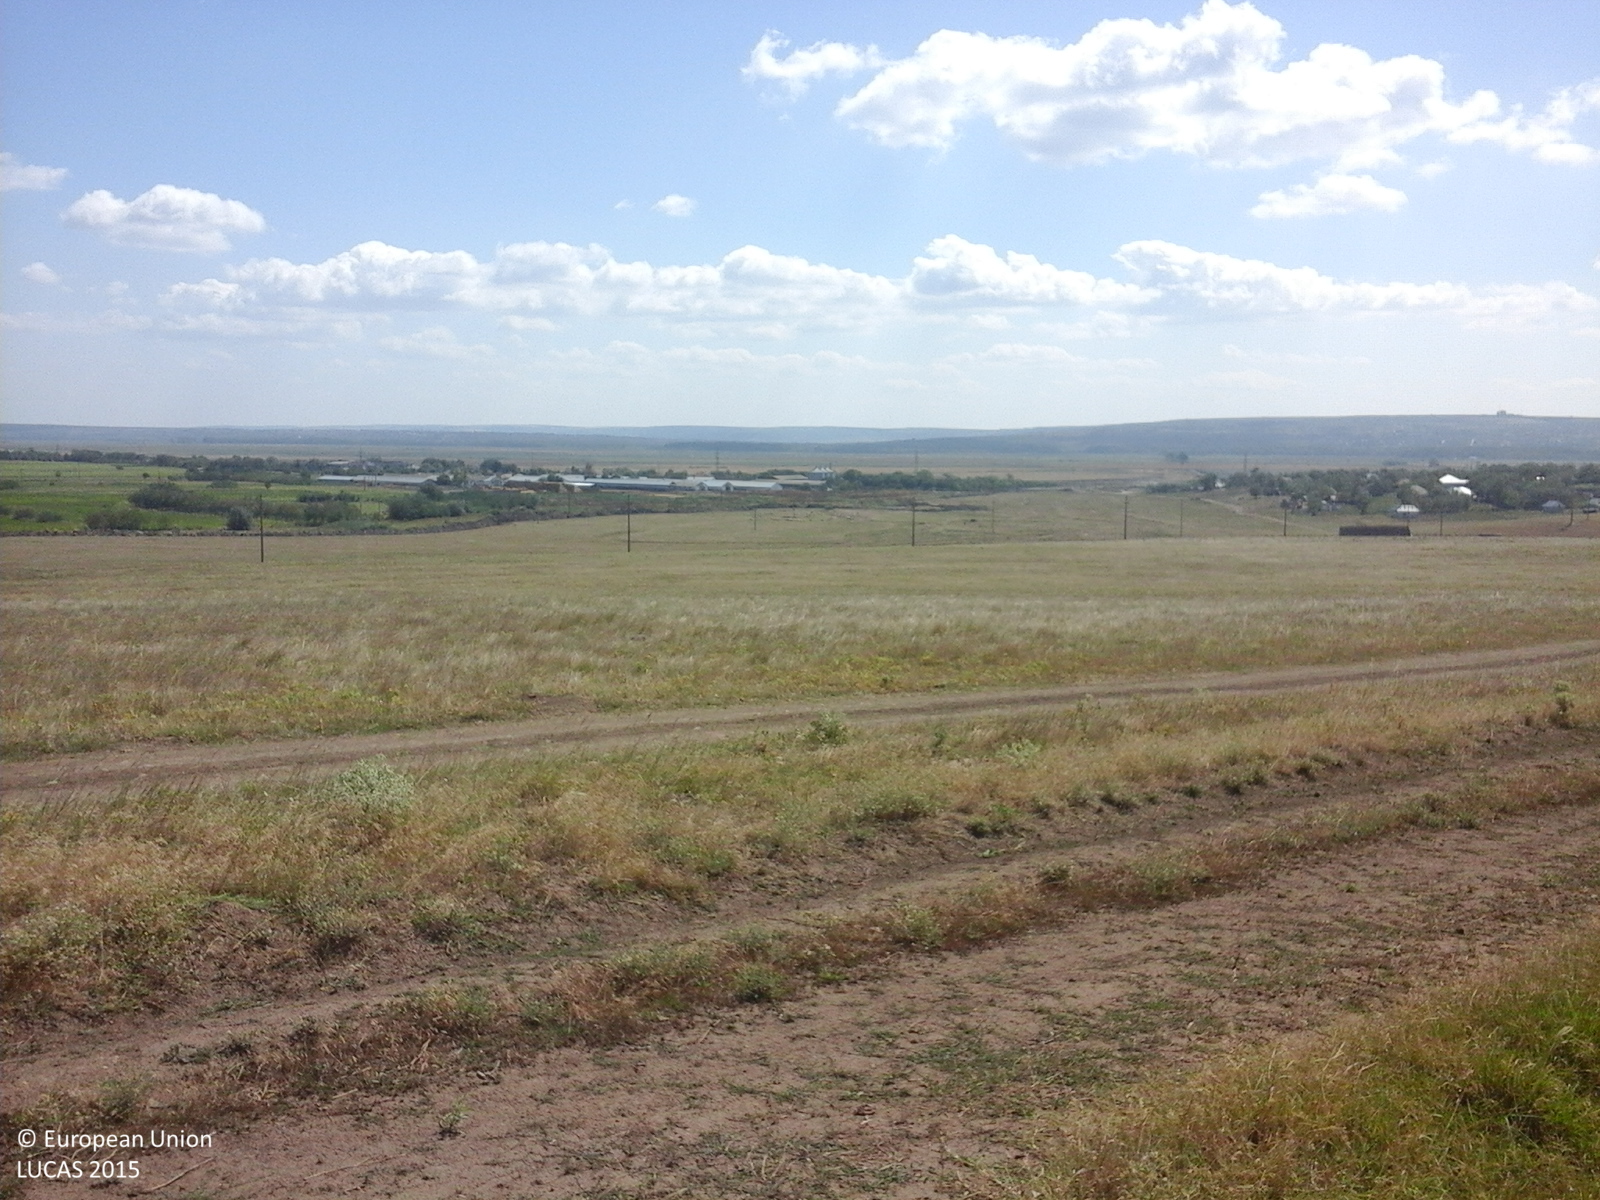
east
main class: Grassland
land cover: Grassland without tree/shrub cover
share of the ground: > 75 %
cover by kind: herbaceous plants 100 %
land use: Agriculture (excluding fallow land and kitchen gardens)
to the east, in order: Grassland without tree/shrub cover; Tracks; Grass margins; Tracks; Grassland without tree/shrub cover
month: July
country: RO
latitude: 46.3878
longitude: 28.1399
